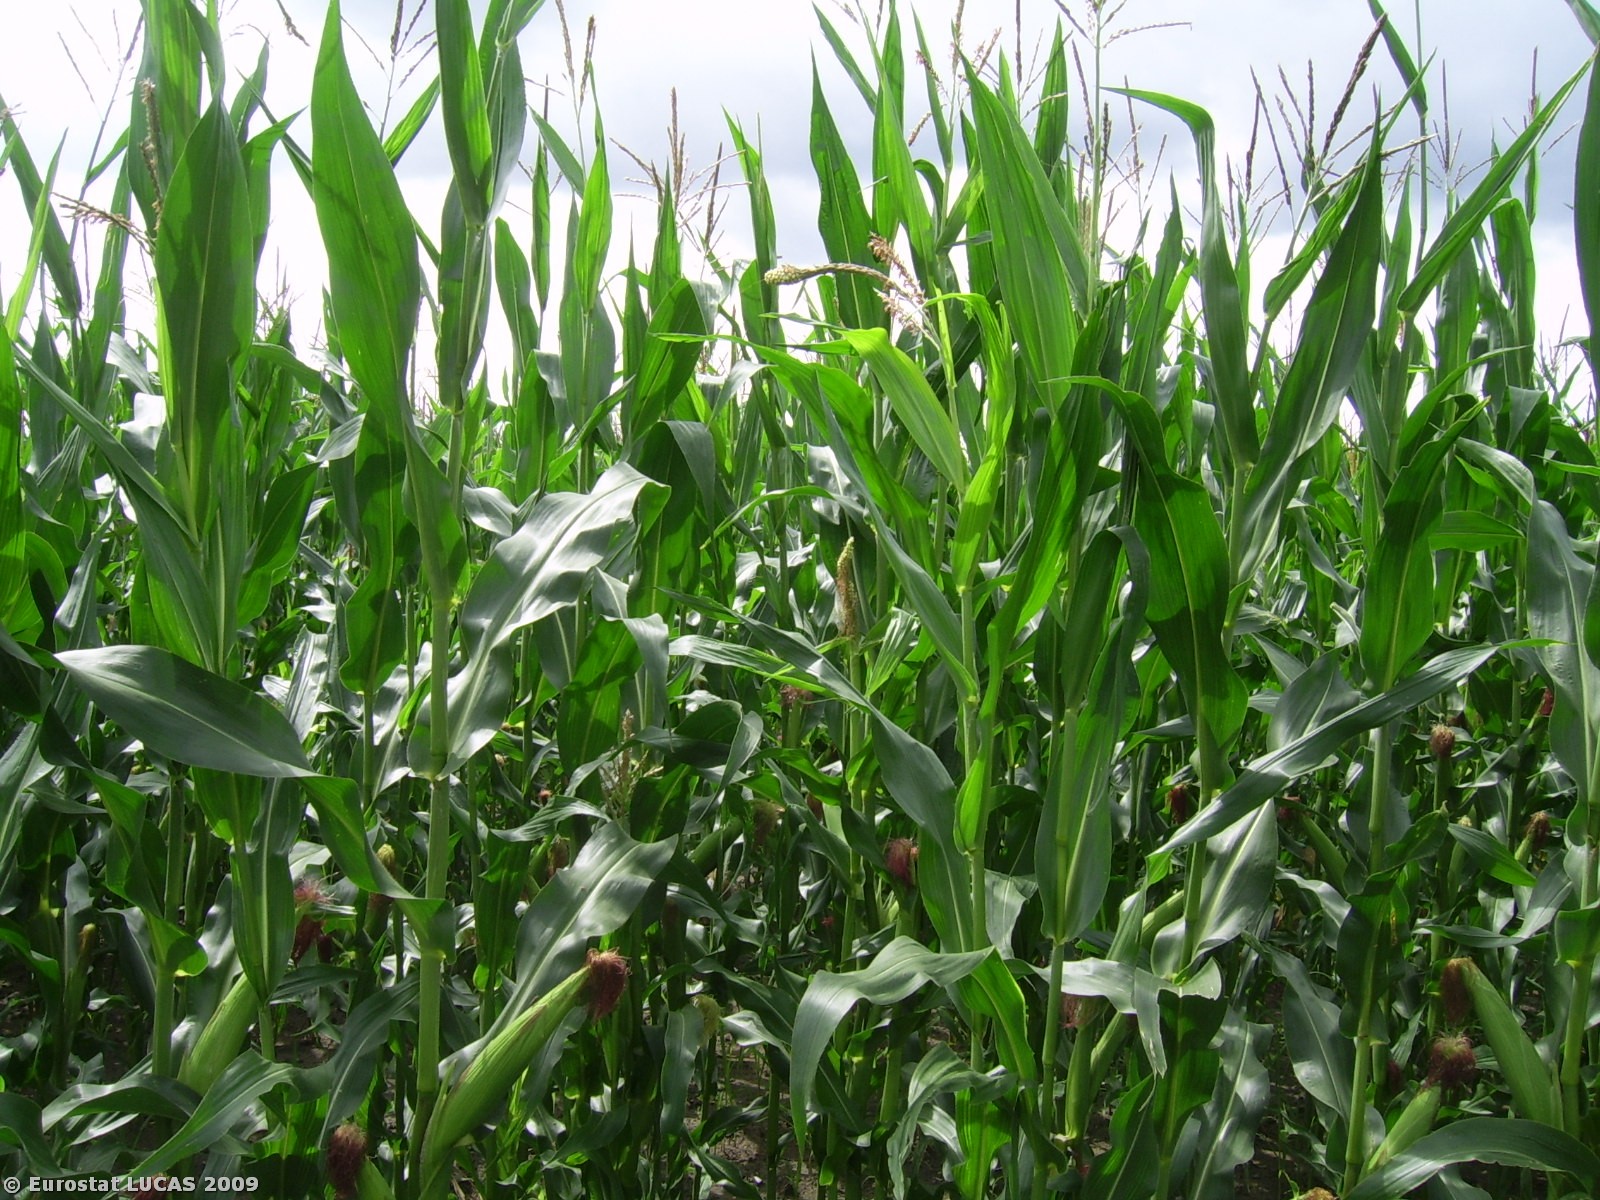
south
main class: Cropland
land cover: Maize
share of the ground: > 75 %
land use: Agriculture (excluding fallow land and kitchen gardens)
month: July
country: PL
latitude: 51.6566
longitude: 16.8466
